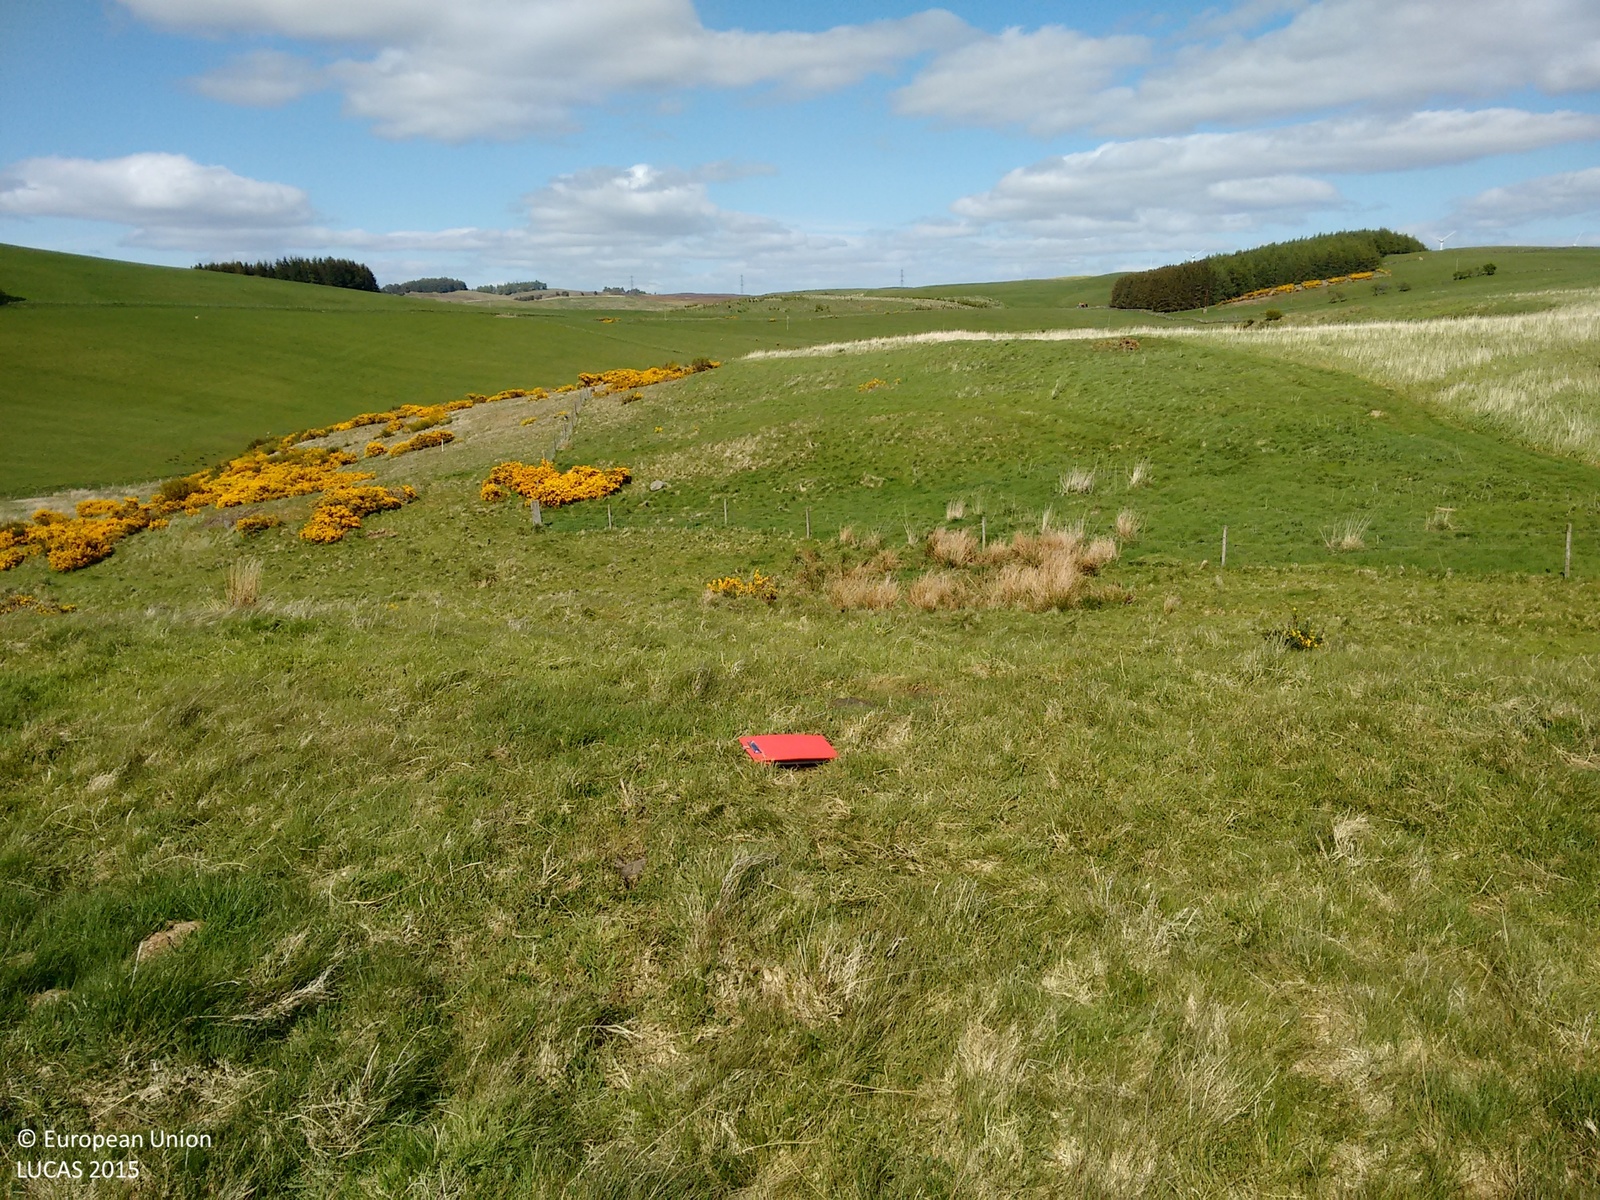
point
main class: Shrubland
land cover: Shrubland without tree cover
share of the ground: > 75 %
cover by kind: herbaceous plants 85 %, shrubs 15 %
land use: Agriculture (excluding fallow land and kitchen gardens)
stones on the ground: < 10 %
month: May
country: GB
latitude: 56.2948
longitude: -3.4705
